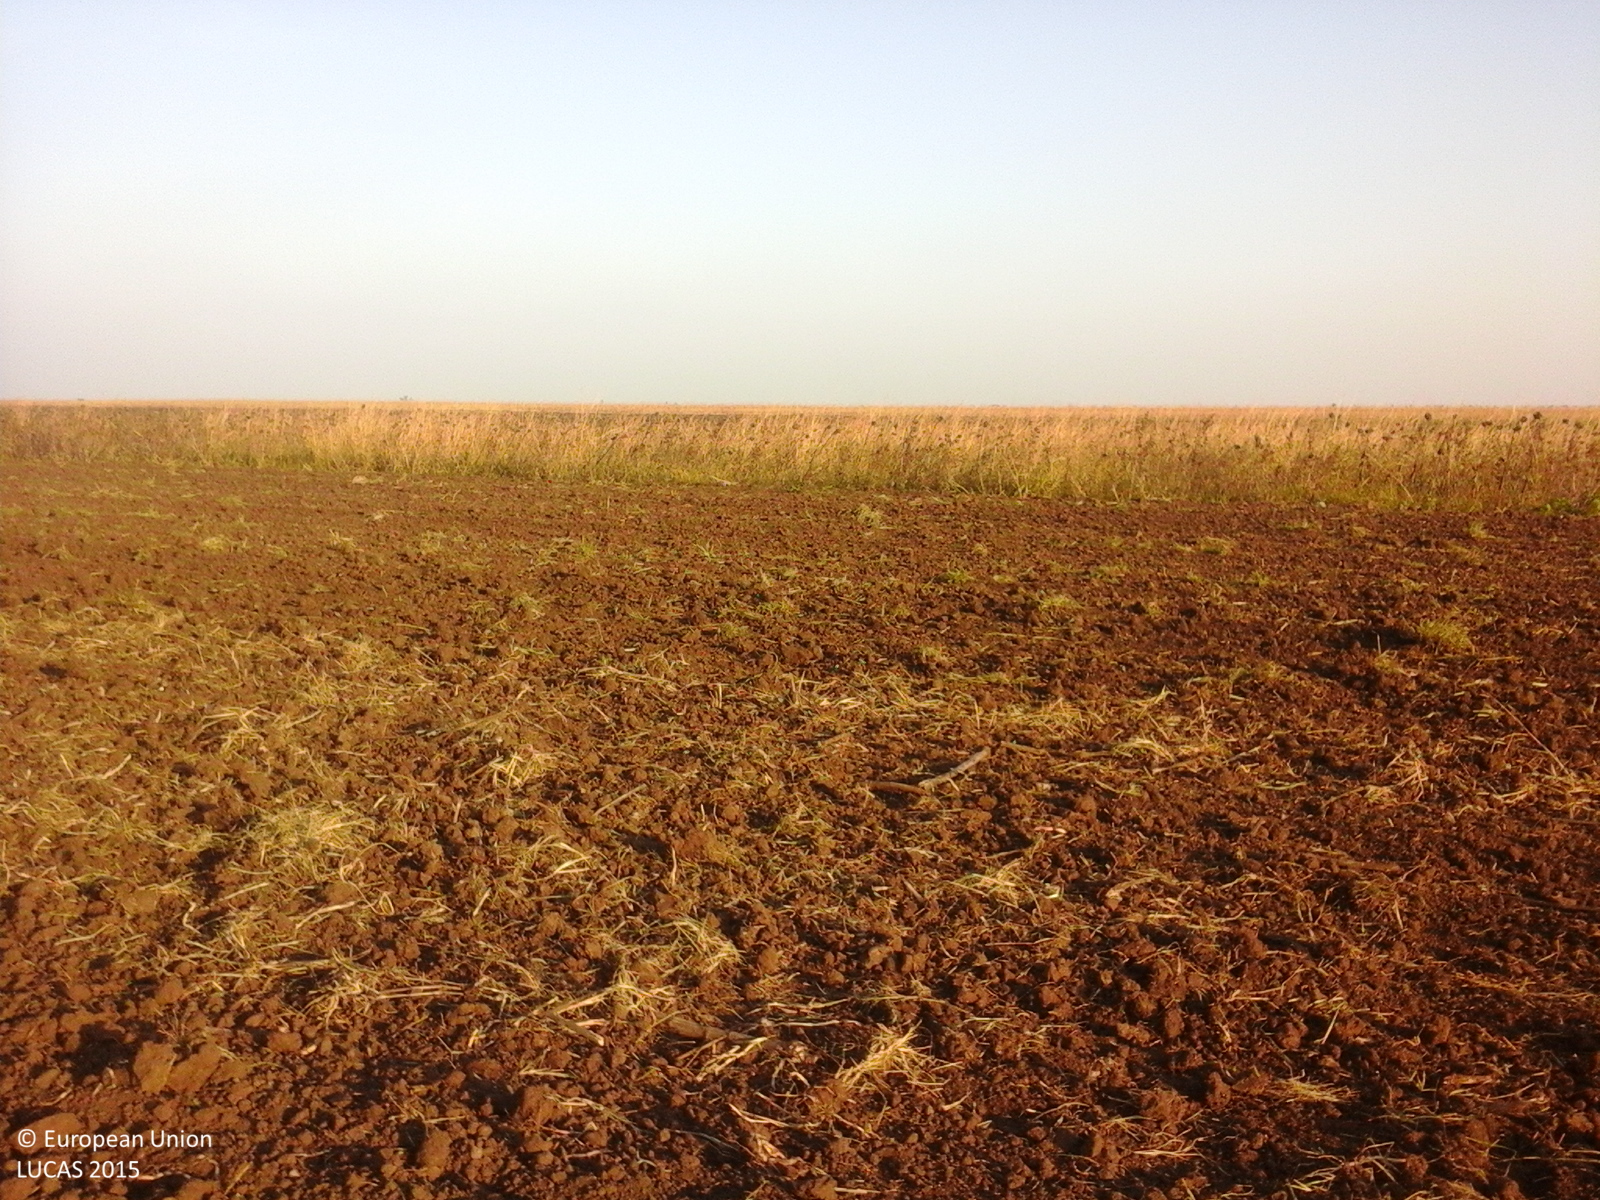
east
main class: Cropland
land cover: Sunflower
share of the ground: < 10 %
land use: Agriculture (excluding fallow land and kitchen gardens)
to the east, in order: Sunflower; Common wheat; Other bare soil; Lucerne; Other bare soil; Maize; Spontaneously vegetated surfaces; Maize
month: October
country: RO
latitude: 45.1574
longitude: 26.9120
